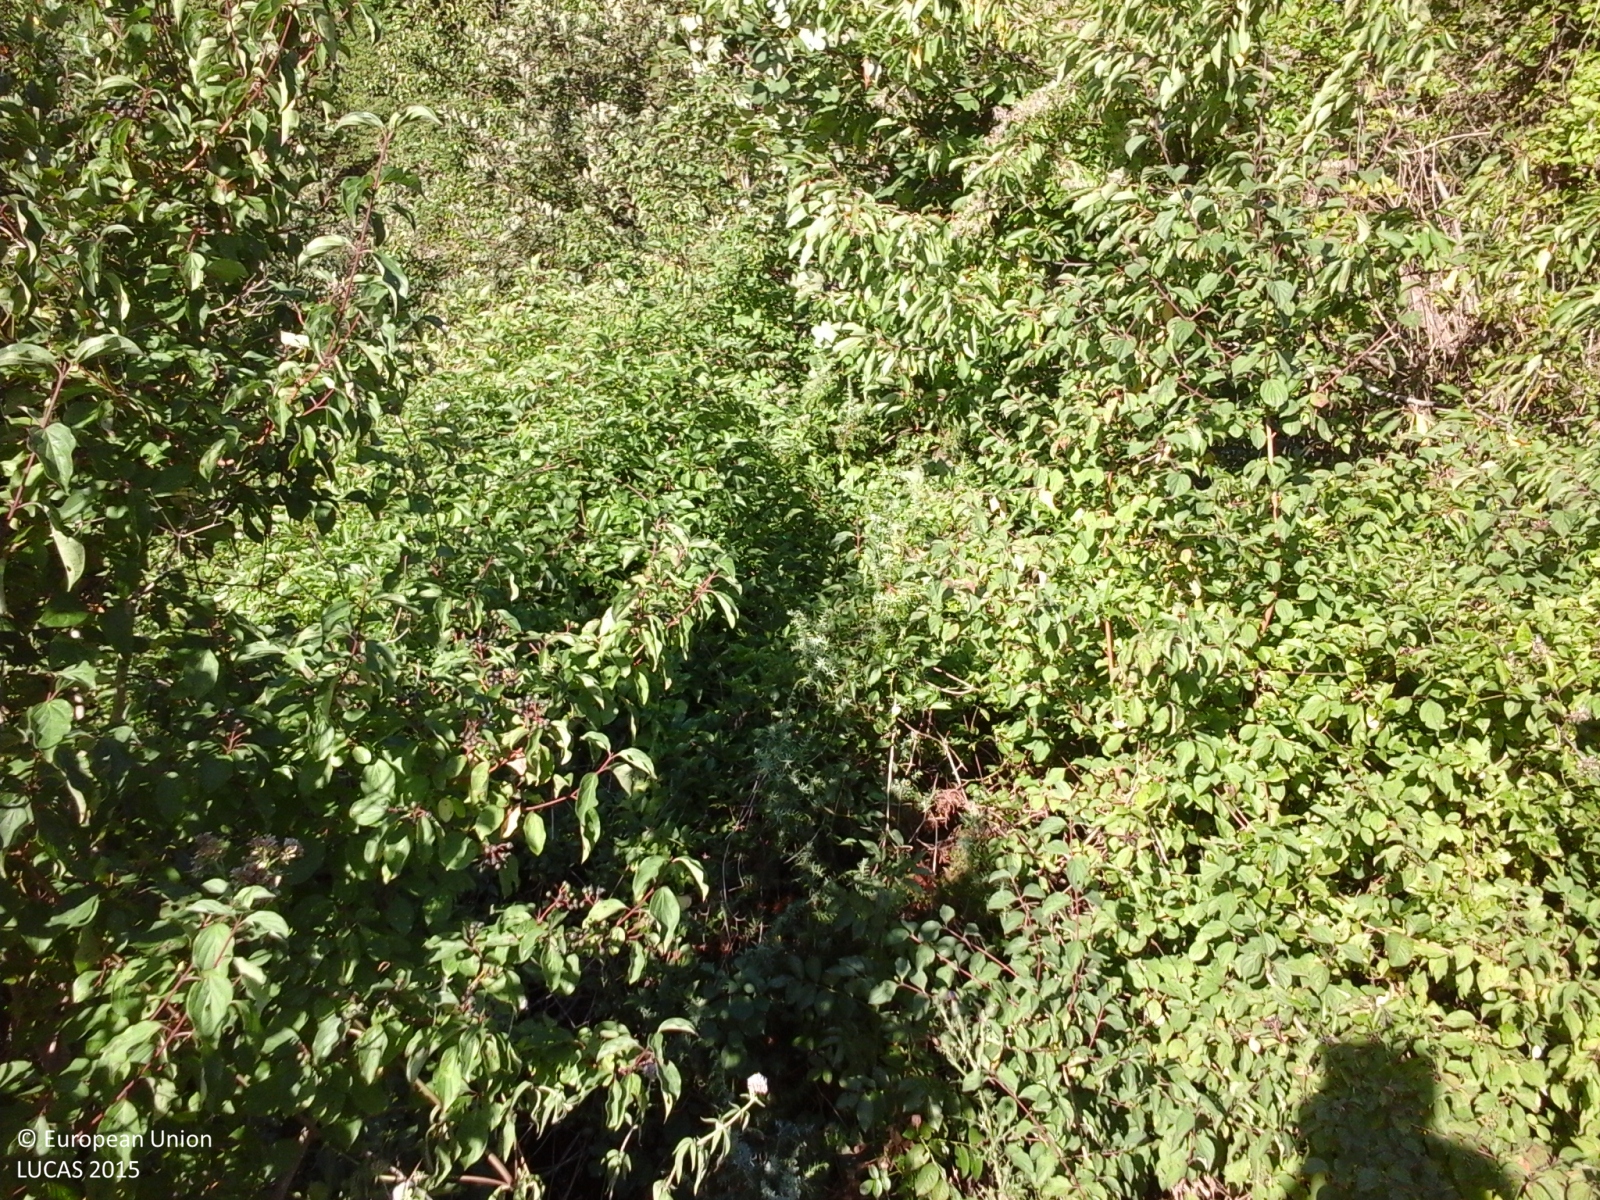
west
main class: Woodland
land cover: Broadleaved woodland
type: thermophilous deciduous forest
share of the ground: > 75 %
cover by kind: broadleaved forest trees 100 %
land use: Semi-natural and natural areas not in use
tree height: > 5 m
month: August
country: IT
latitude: 43.4924
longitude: 12.4050
